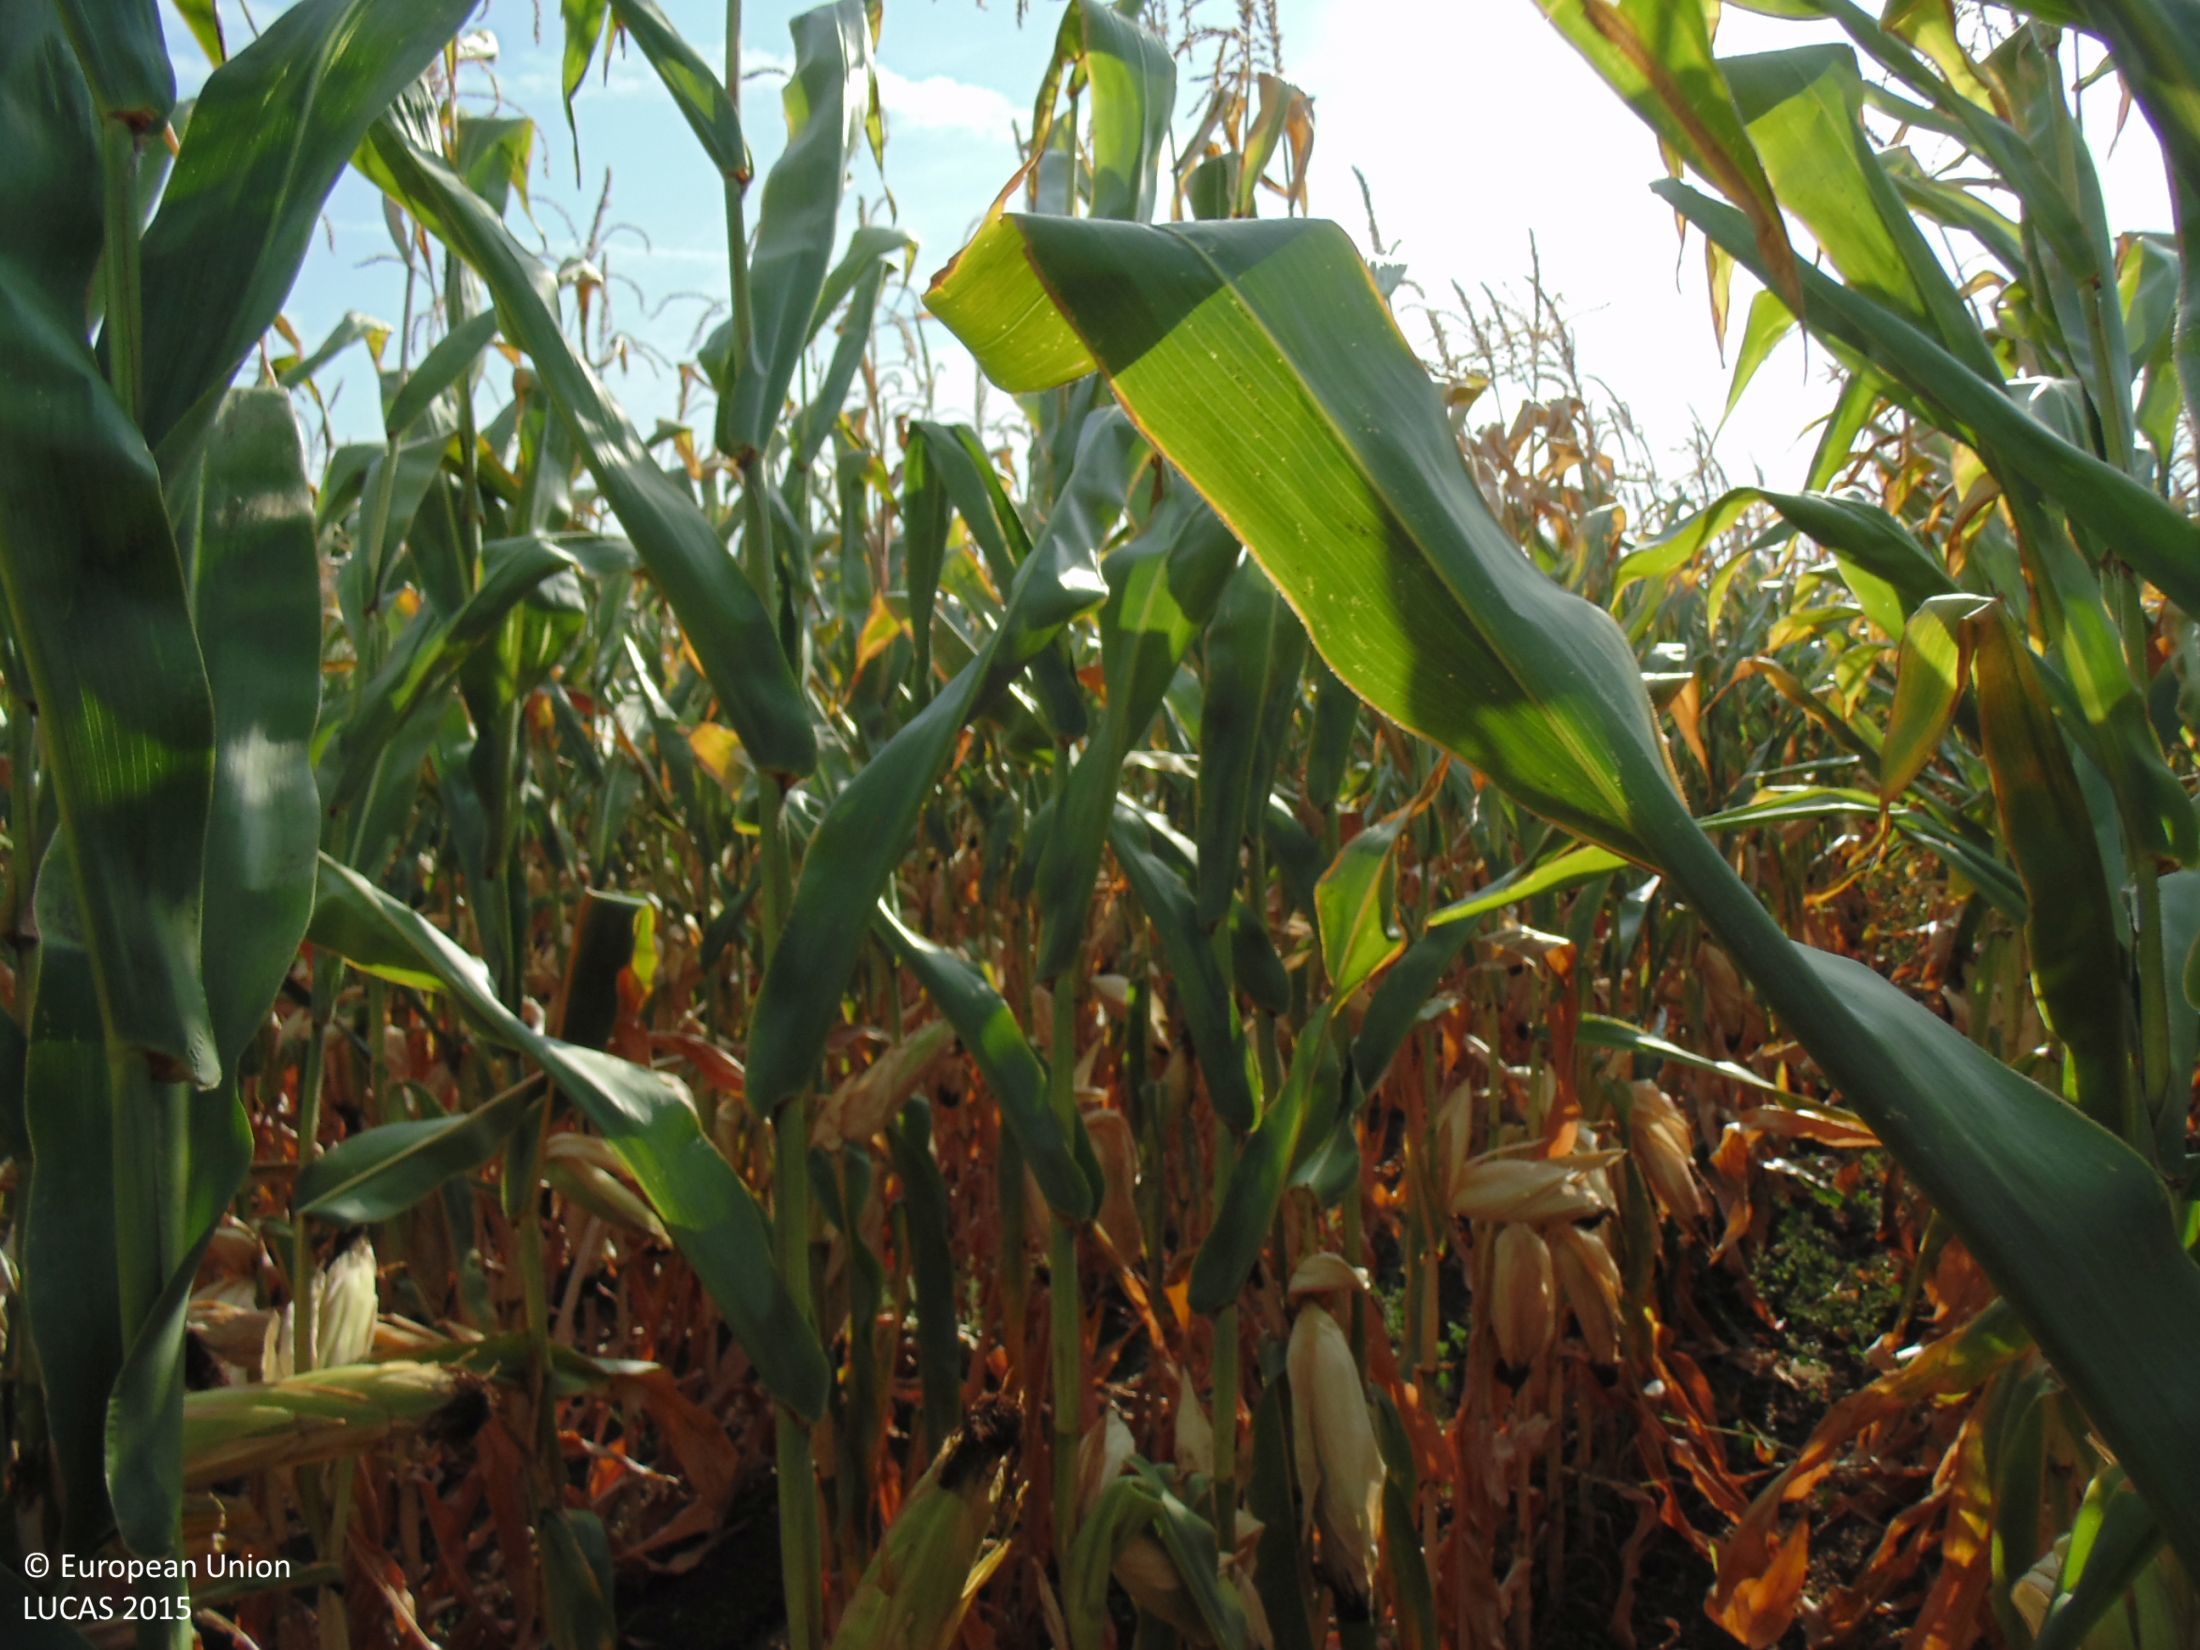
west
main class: Cropland
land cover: Maize
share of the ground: > 75 %
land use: Agriculture (excluding fallow land and kitchen gardens)
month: August
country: BG
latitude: 43.7268
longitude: 28.3713
